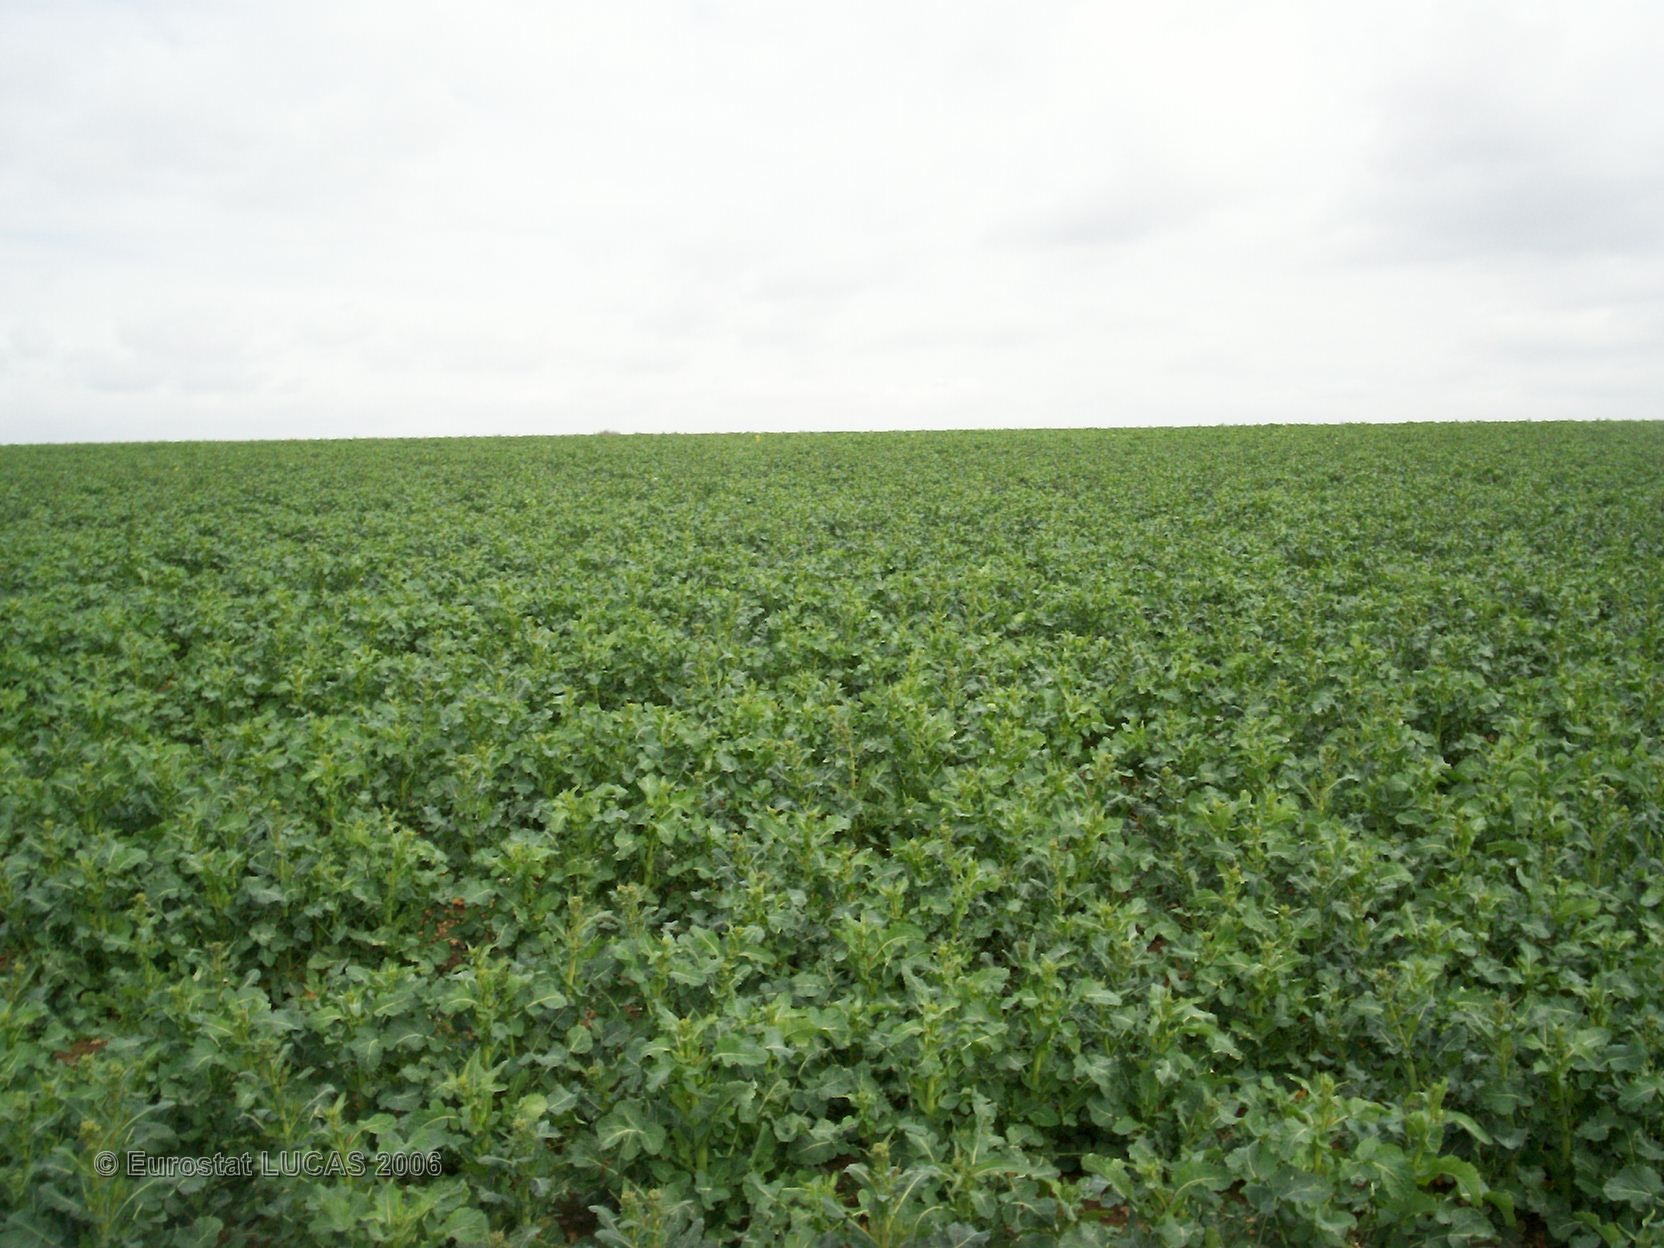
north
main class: Cropland
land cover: Rape and turnip rape
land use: Agriculture (excluding fallow land and kitchen gardens)
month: April
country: FR
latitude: 49.7284
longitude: 0.8898
